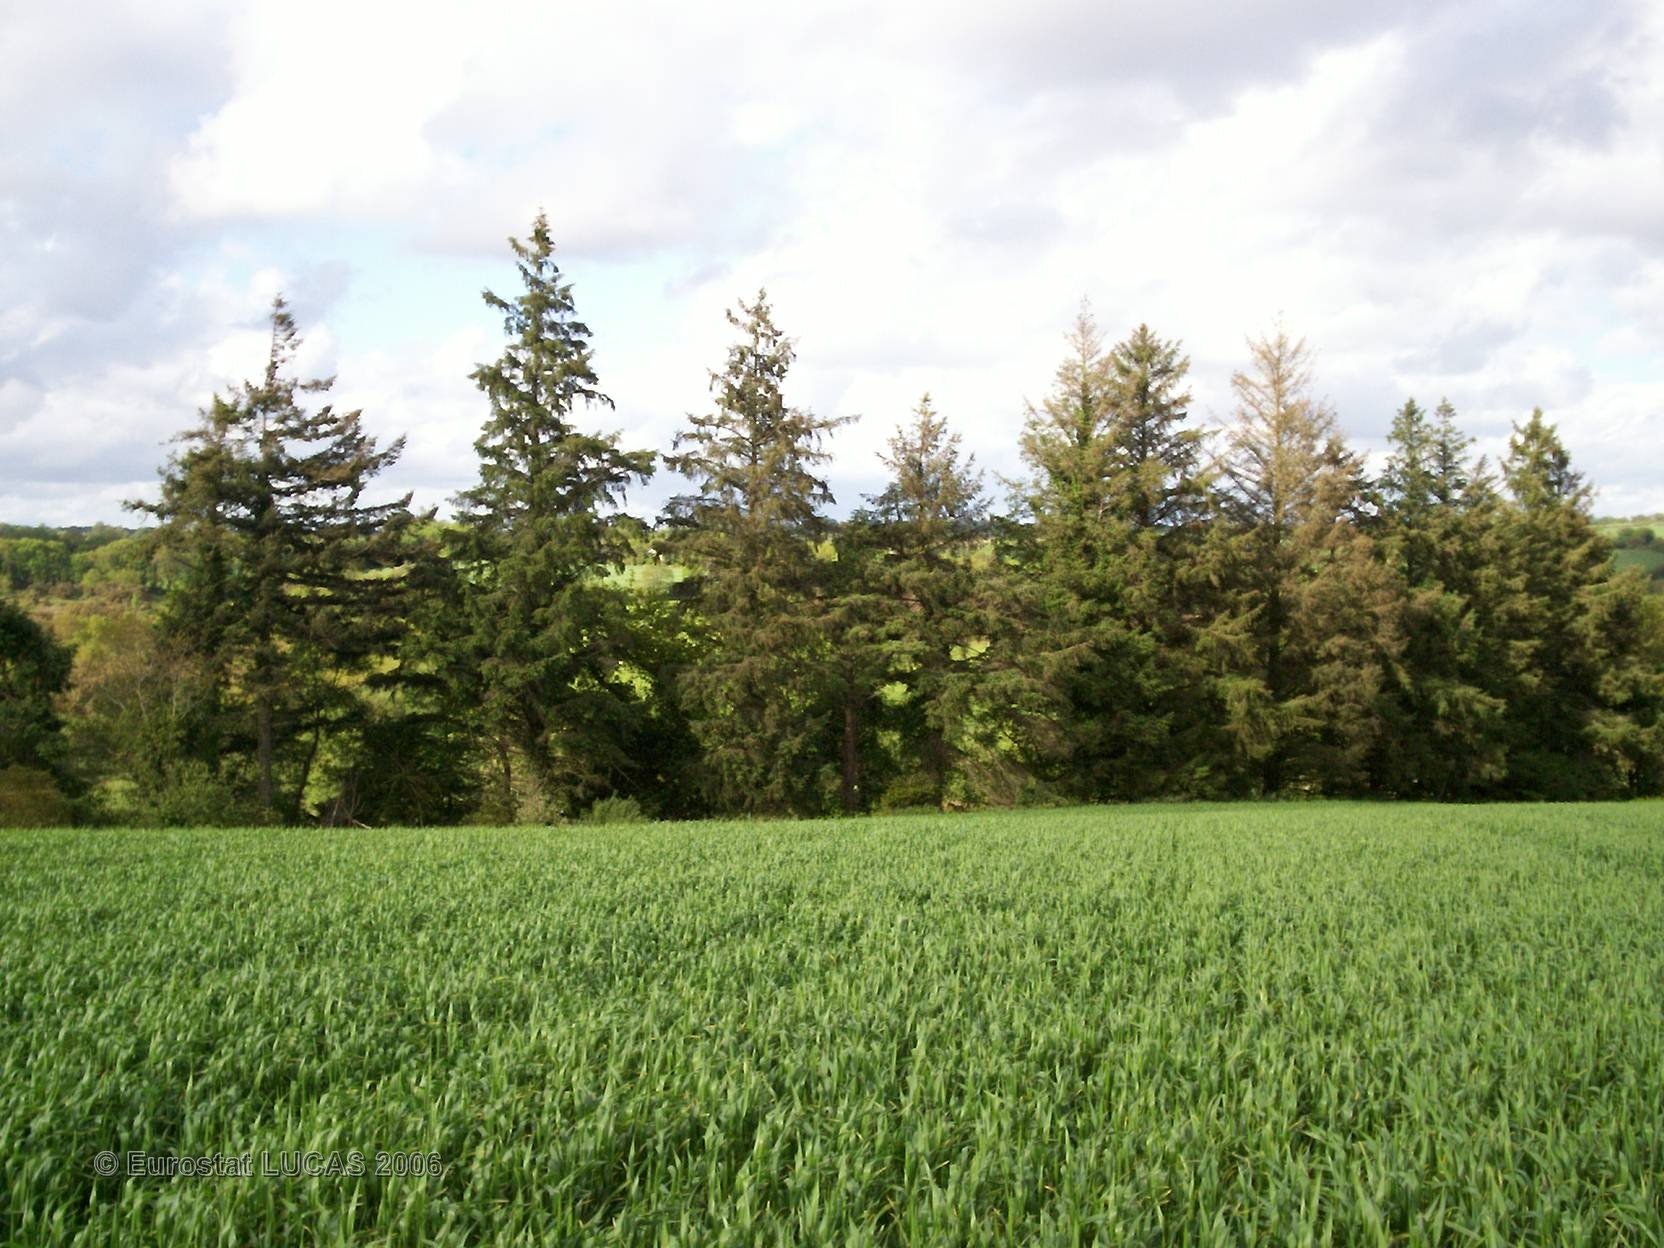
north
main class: Cropland
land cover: Common wheat
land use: Agriculture (excluding fallow land and kitchen gardens)
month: May
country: FR
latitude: 47.9981
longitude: -3.8745
